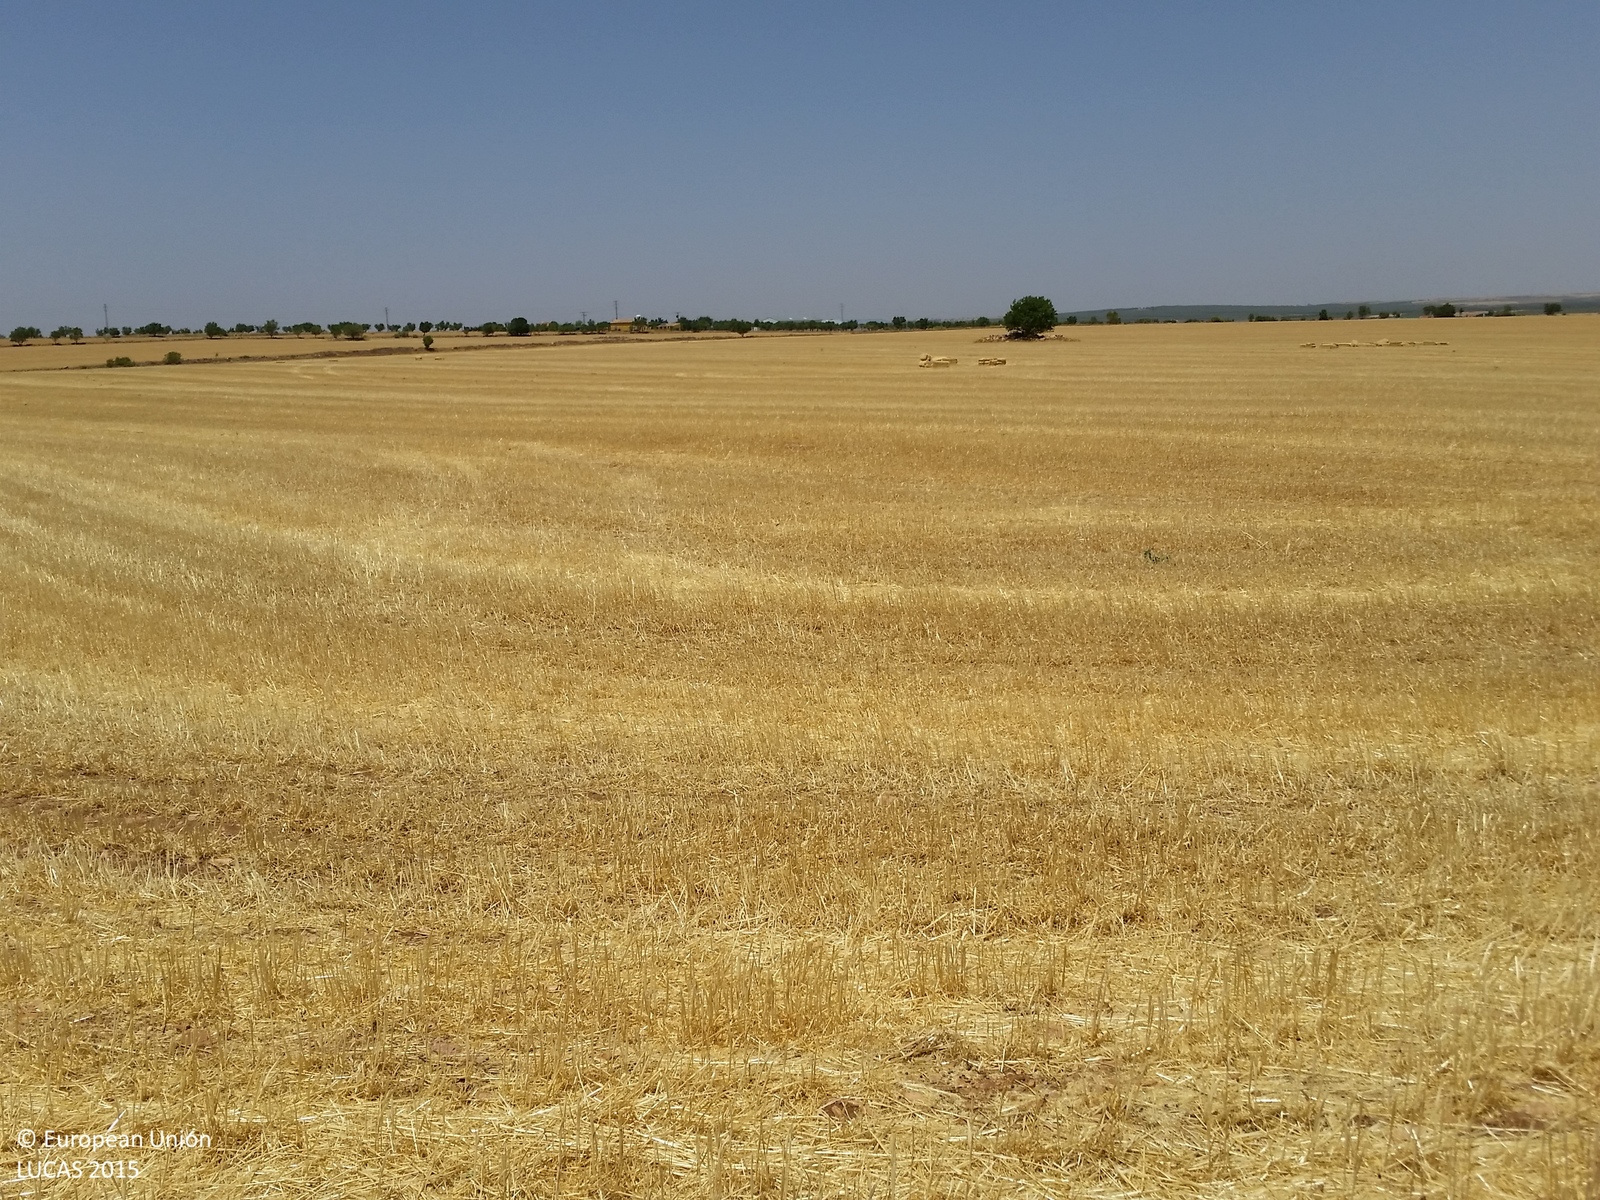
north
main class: Cropland
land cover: Barley
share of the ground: < 10 %
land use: Agriculture (excluding fallow land and kitchen gardens)
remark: Harvested field
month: July
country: ES
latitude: 38.8687
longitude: -2.5788
